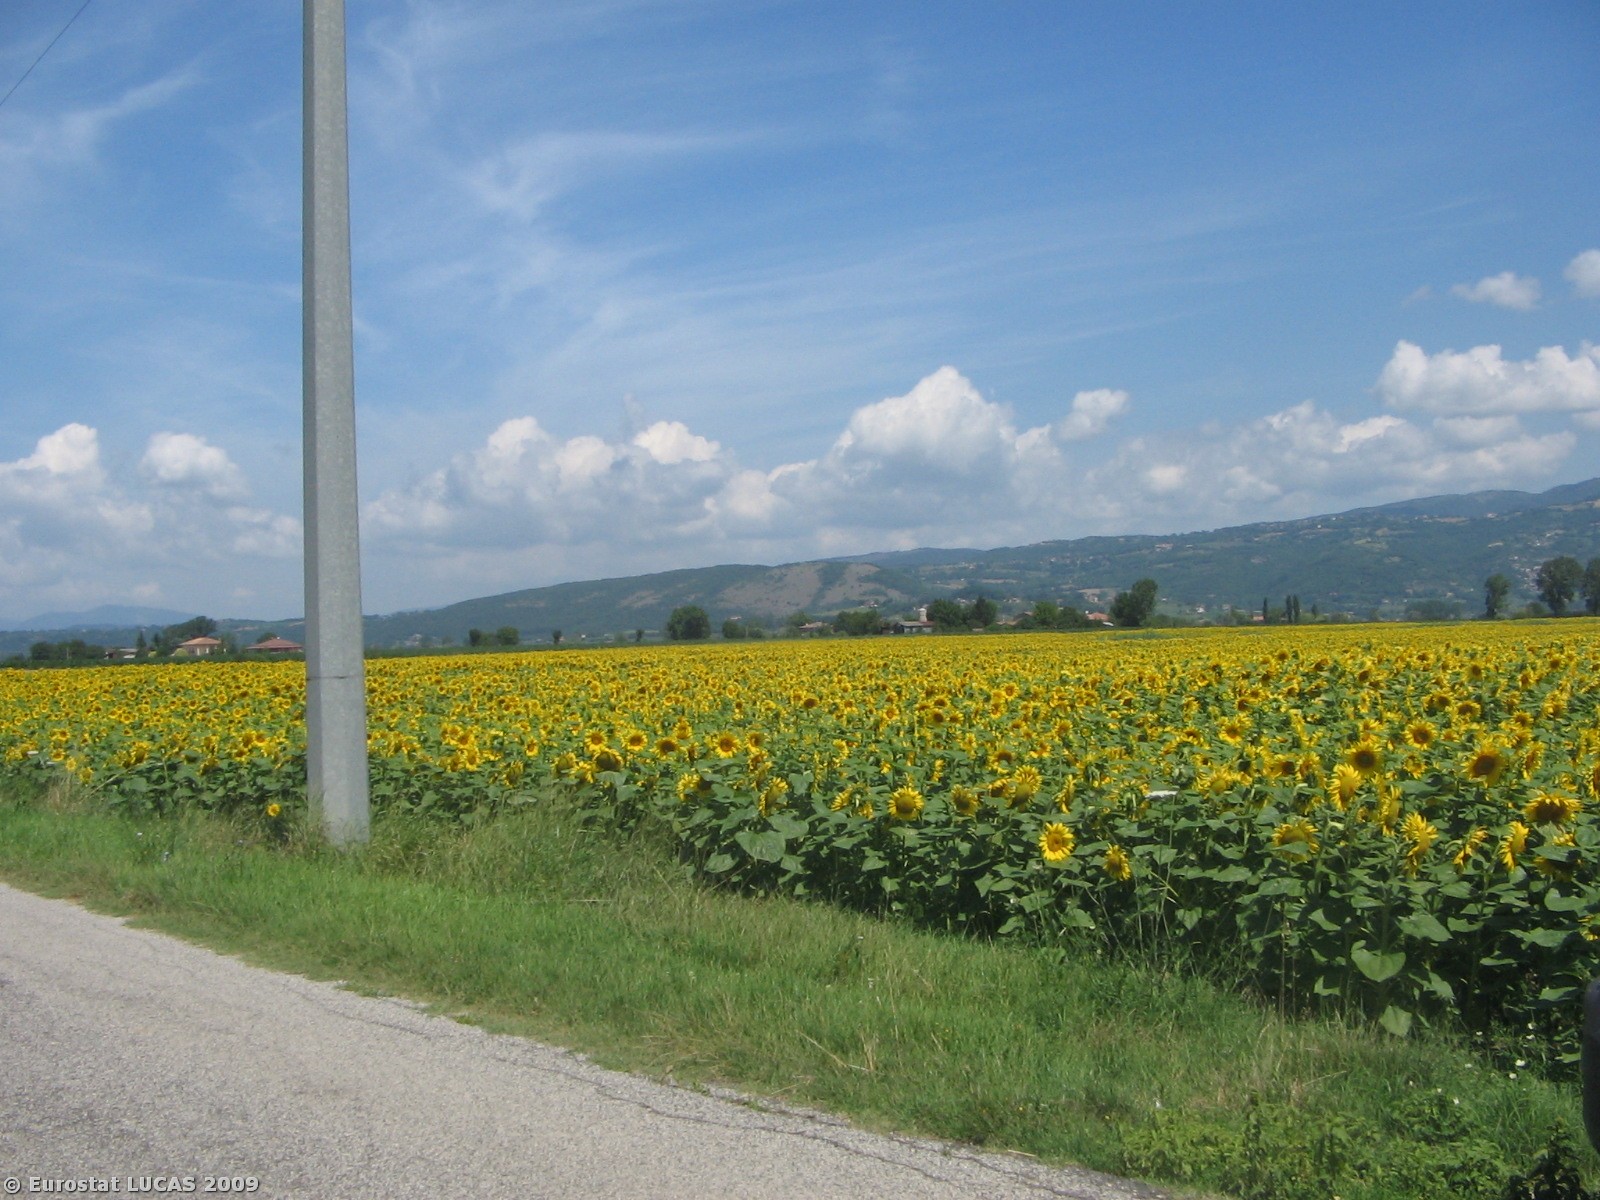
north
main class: Cropland
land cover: Barley
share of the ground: > 75 %
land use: Agriculture (excluding fallow land and kitchen gardens)
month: July
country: IT
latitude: 42.4513
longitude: 12.8481
